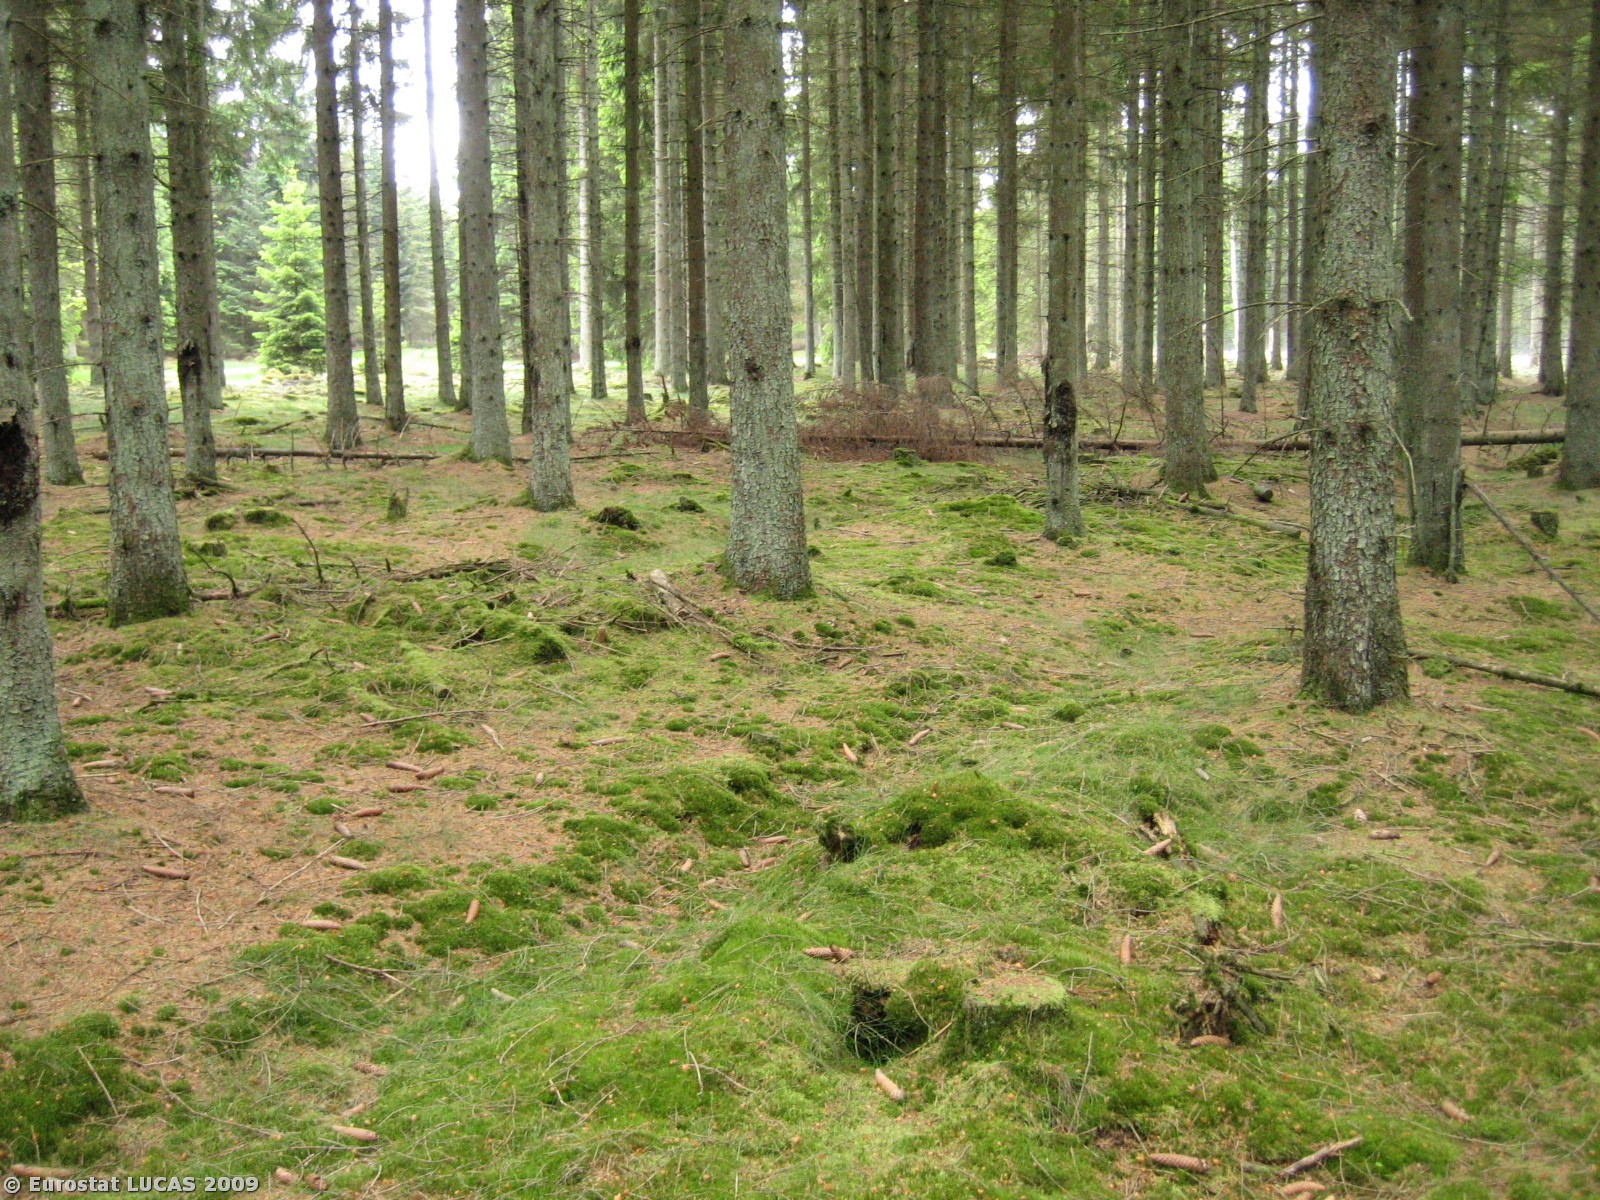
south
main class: Woodland
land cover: Coniferous woodland
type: hemiboreal forest and nemoral coniferous forest and mixed broadleaved-coniferous forest
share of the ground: 50 - 75 %
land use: Forestry
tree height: > 5 m
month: May
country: DK
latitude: 56.0780
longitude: 9.3099
